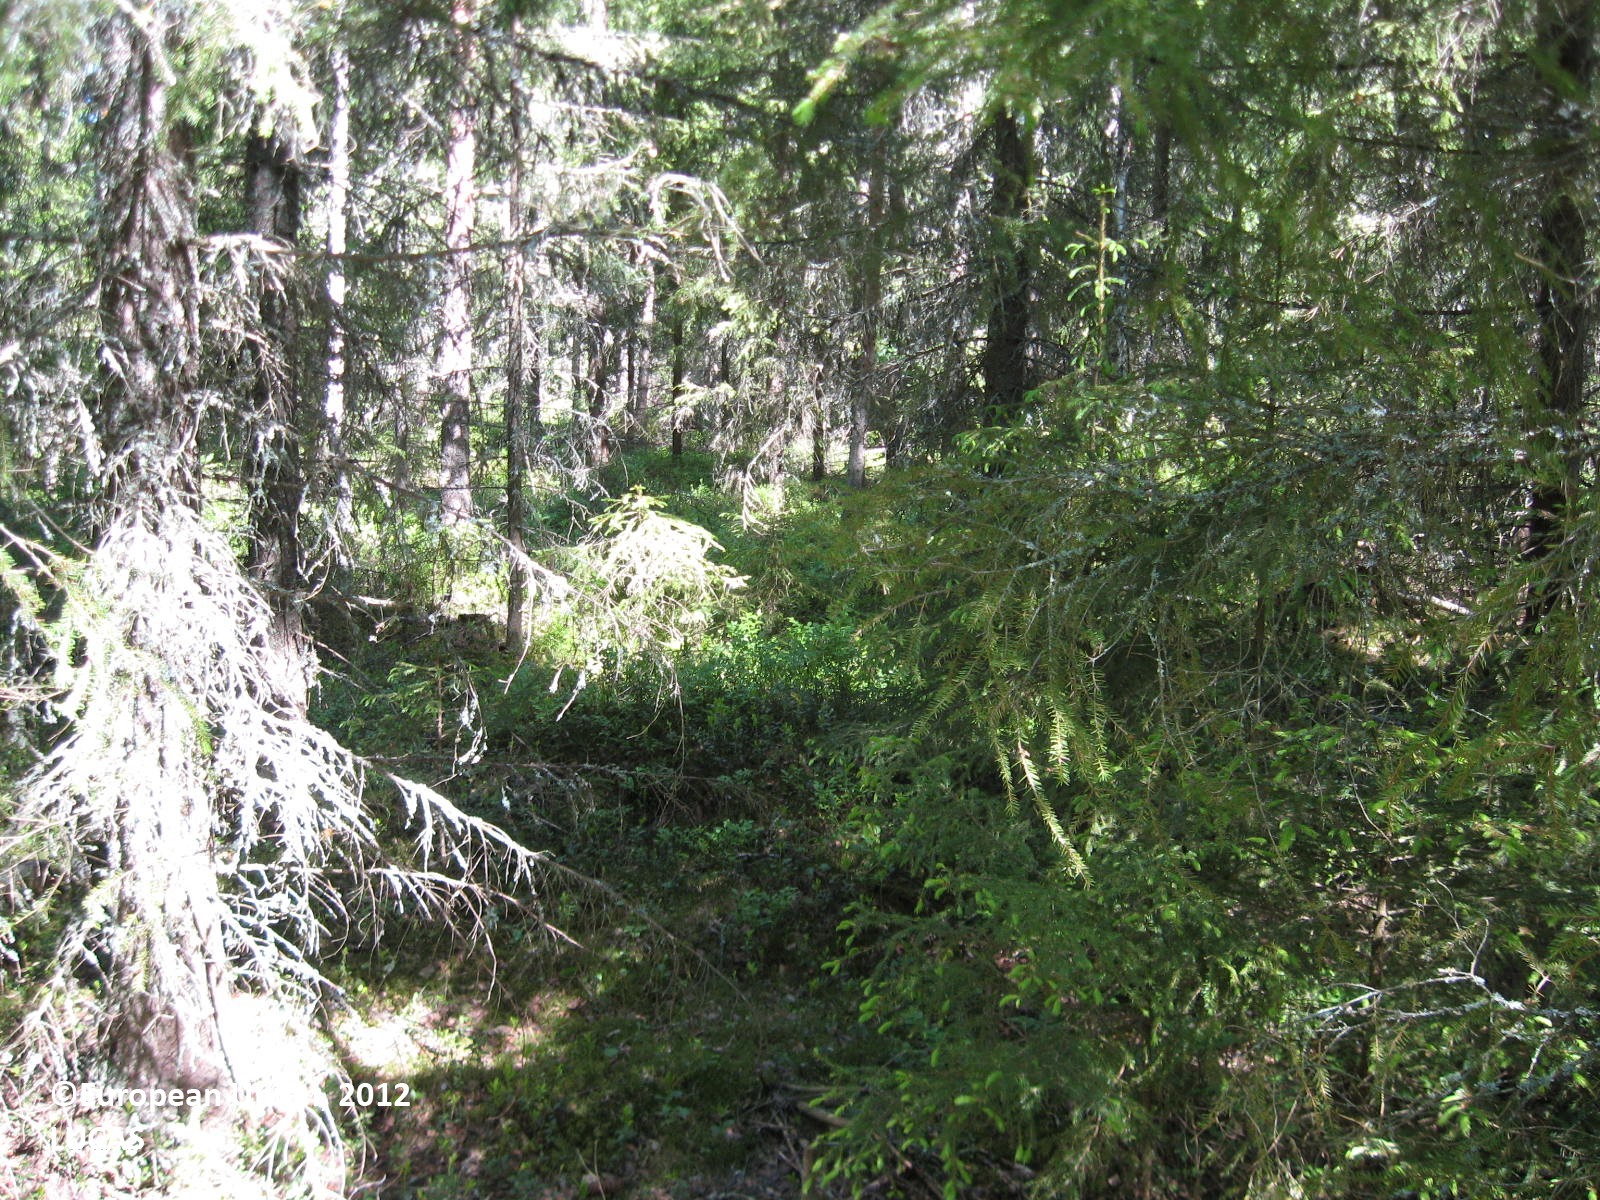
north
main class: Woodland
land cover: Spruce dominated mixed woodland
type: boreal forest
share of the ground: > 75 %
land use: Forestry
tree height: > 5 m
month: June
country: FI
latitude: 62.8049
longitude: 21.3166
